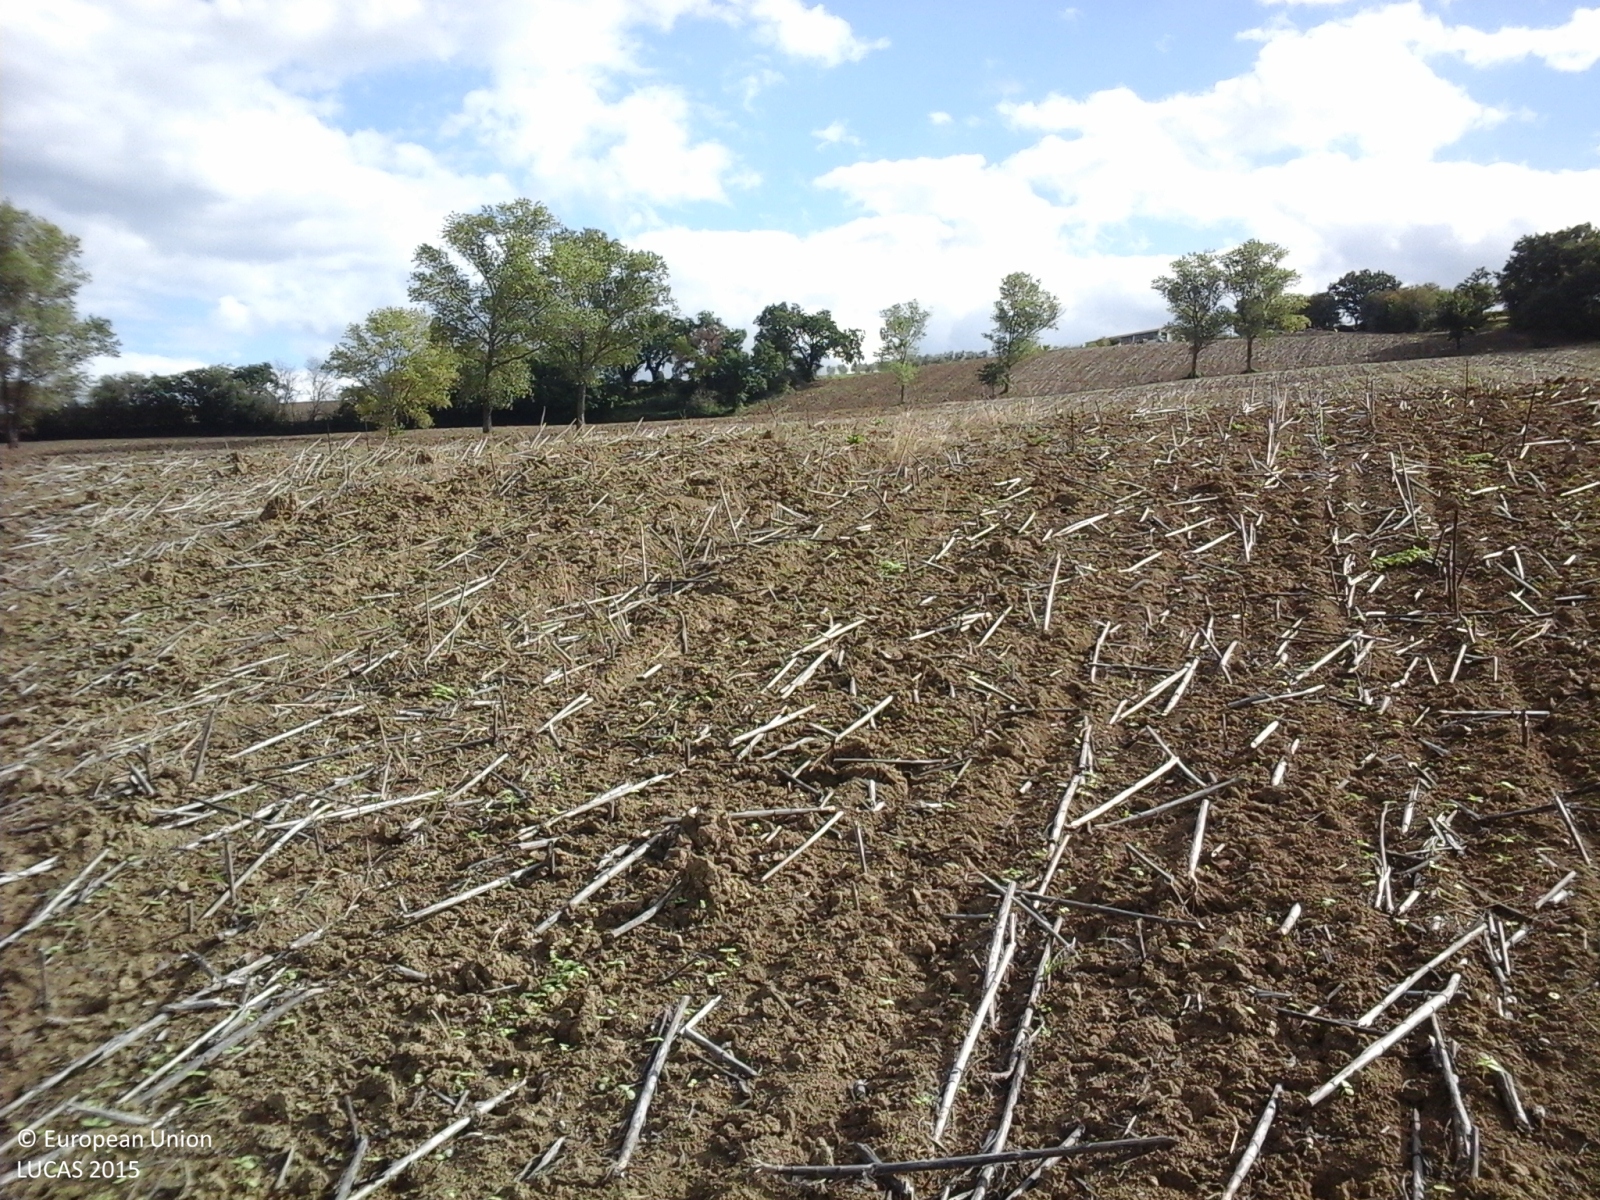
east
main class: Cropland
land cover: Sunflower
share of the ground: < 10 %
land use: Agriculture (excluding fallow land and kitchen gardens)
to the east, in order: Sunflower
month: October
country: IT
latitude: 43.5611
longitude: 13.1986
